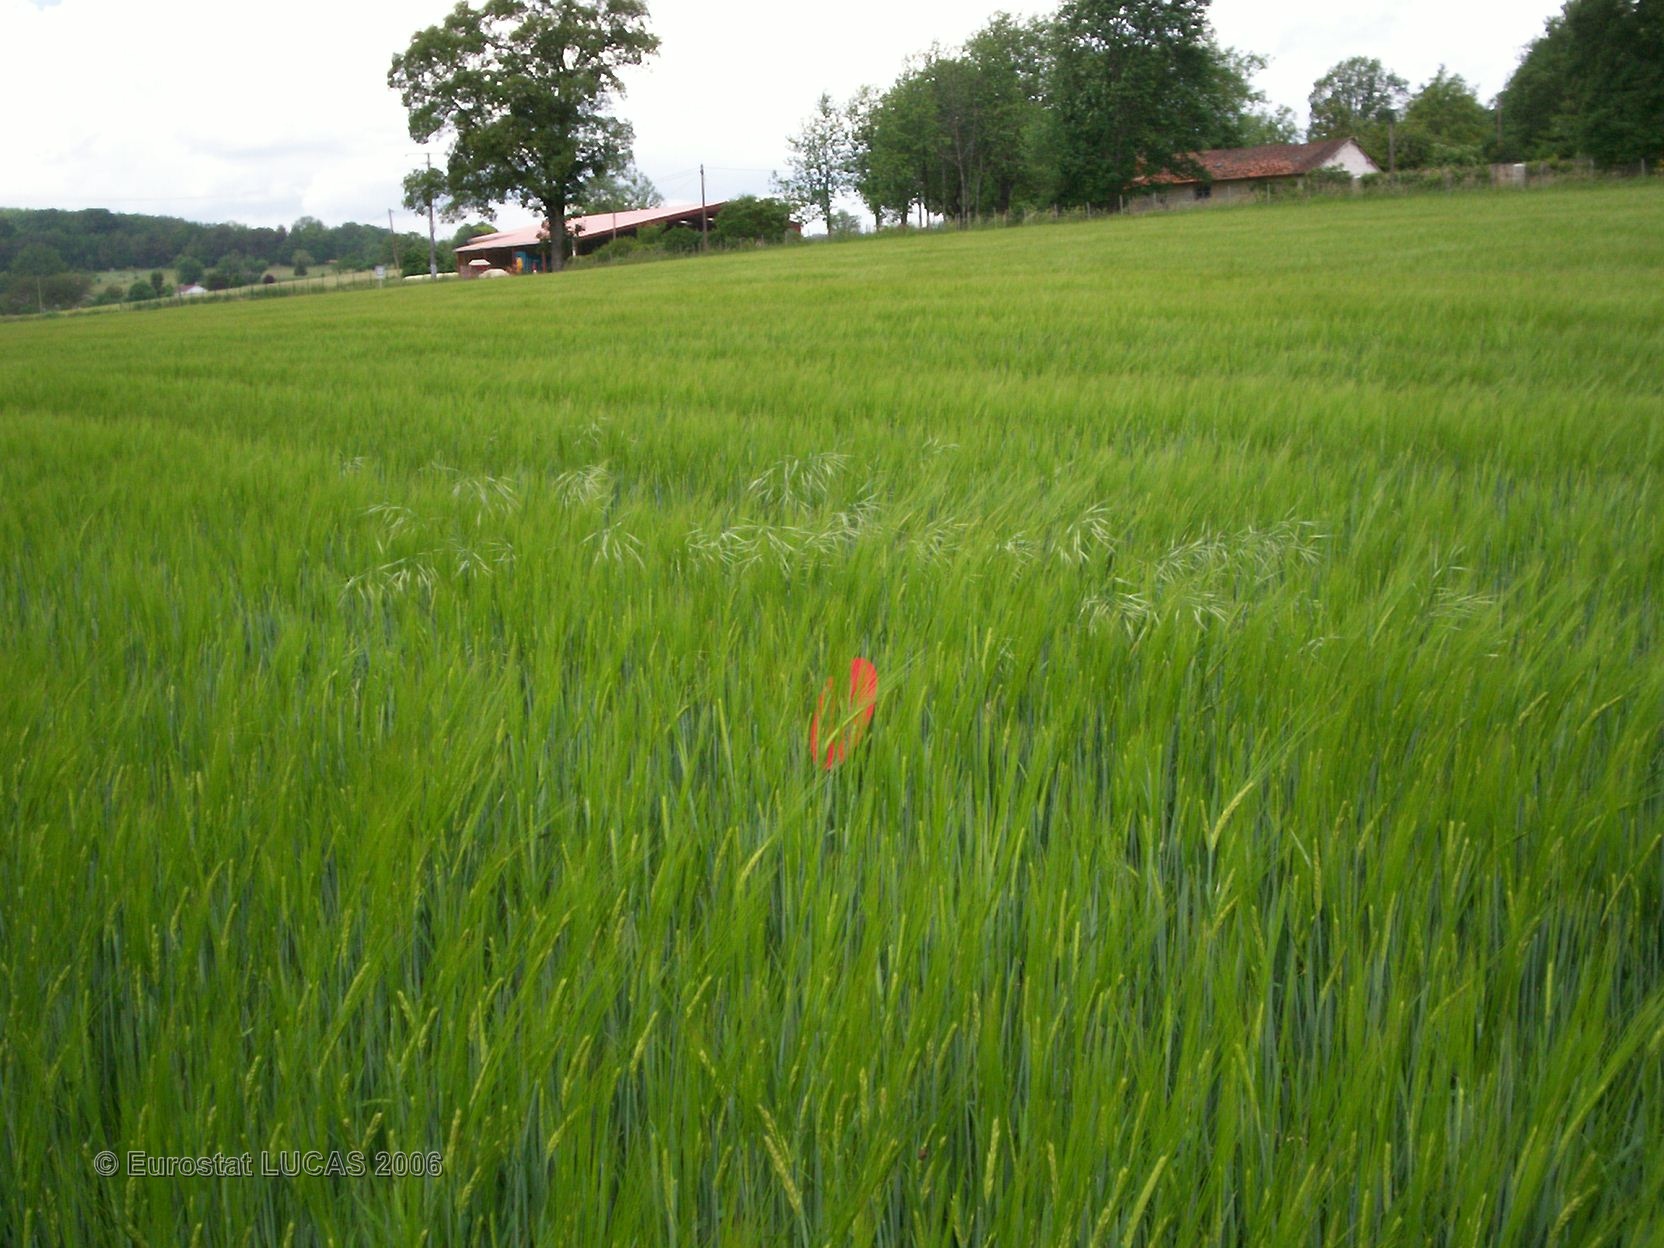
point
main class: Cropland
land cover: Barley
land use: Agriculture (excluding fallow land and kitchen gardens)
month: May
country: FR
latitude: 45.2988
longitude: 0.7700
